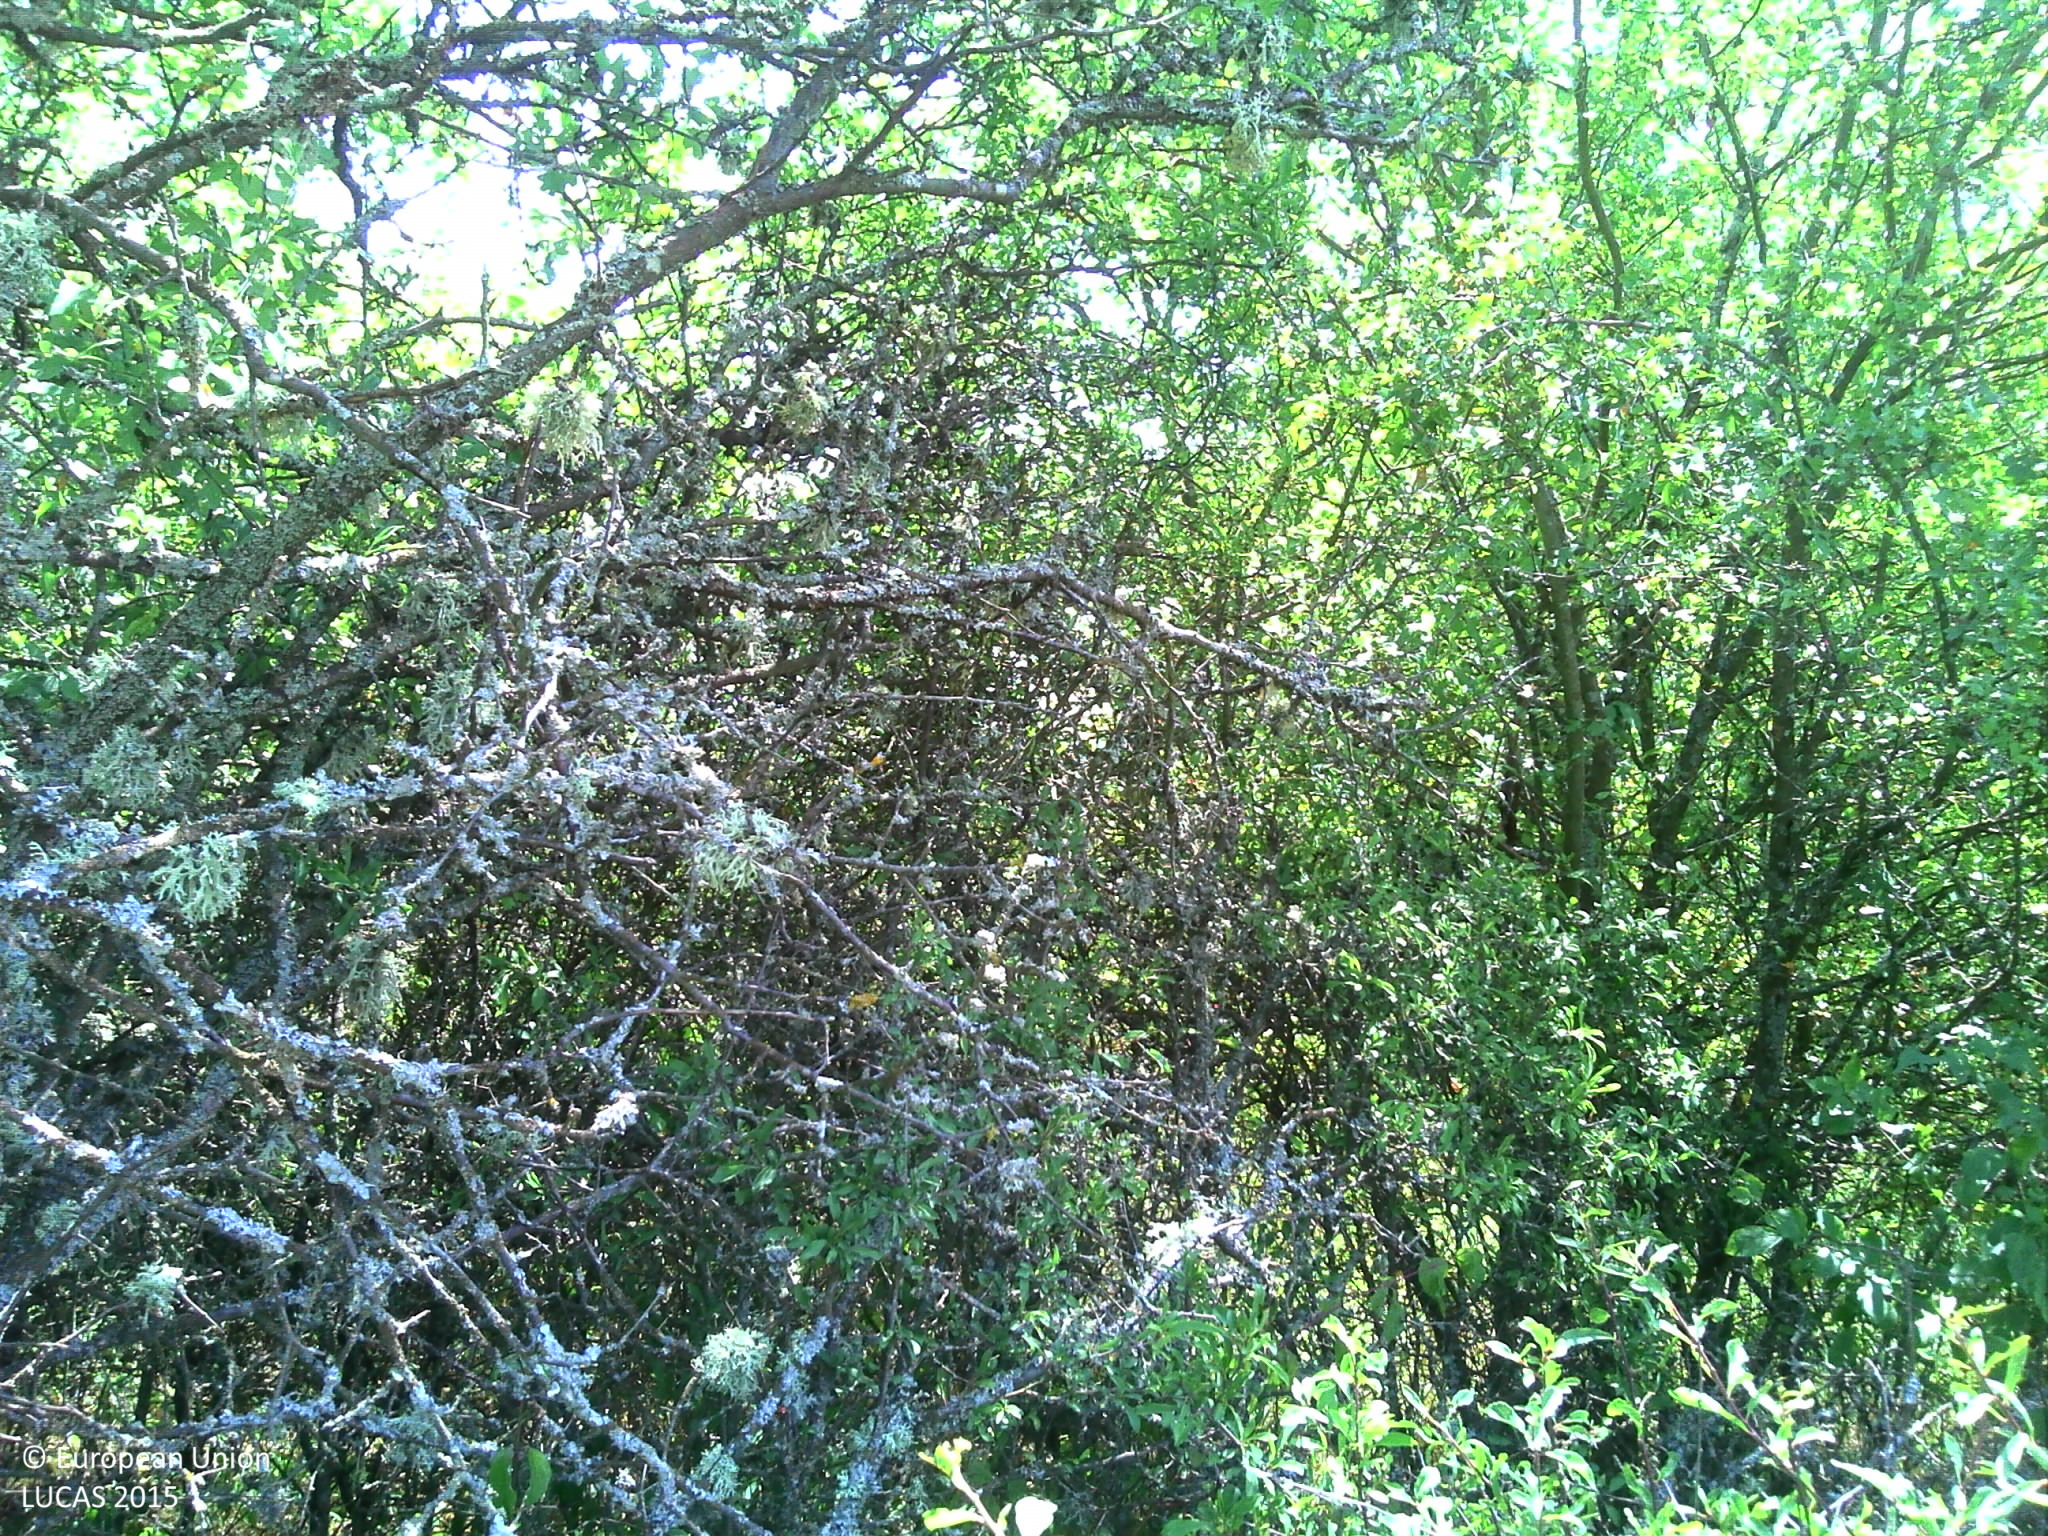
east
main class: Woodland
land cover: Broadleaved woodland
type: mesophytic deciduous forest
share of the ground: > 75 %
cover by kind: broadleaved forest trees 75 %, herbaceous plants 25 %
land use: Agriculture (excluding fallow land and kitchen gardens)
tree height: > 5 m
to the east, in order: Broadleaved woodland; Grassland without tree/shrub cover; Broadleaved woodland; Maize; Grass margins; Tracks; Grass margins; Barley
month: July
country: FR
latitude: 48.5533
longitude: 7.4132
